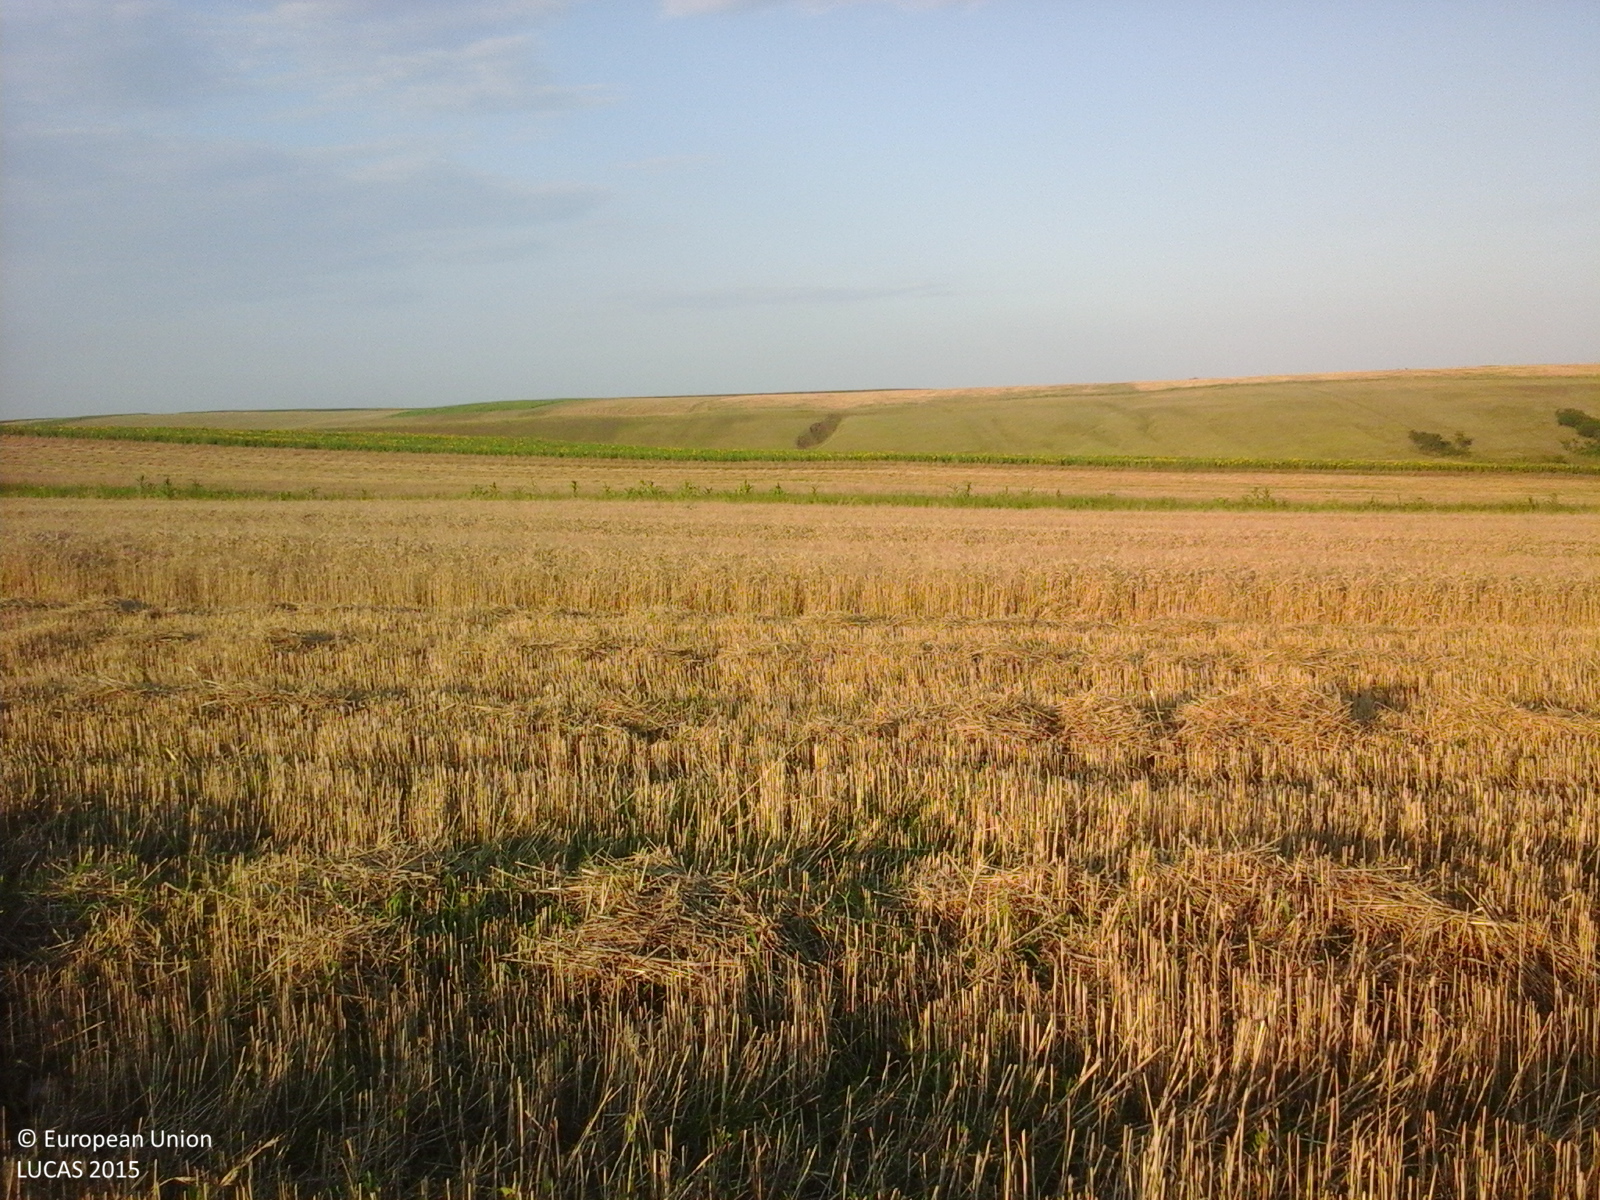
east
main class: Cropland
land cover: Common wheat
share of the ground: 50 - 75 %
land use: Agriculture (excluding fallow land and kitchen gardens)
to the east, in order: Common wheat; Spontaneously vegetated surfaces; Mixed cereals for fodder; Common wheat; Sunflower; Grassland without tree/shrub cover
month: July
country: RO
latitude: 44.2611
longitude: 24.4860
